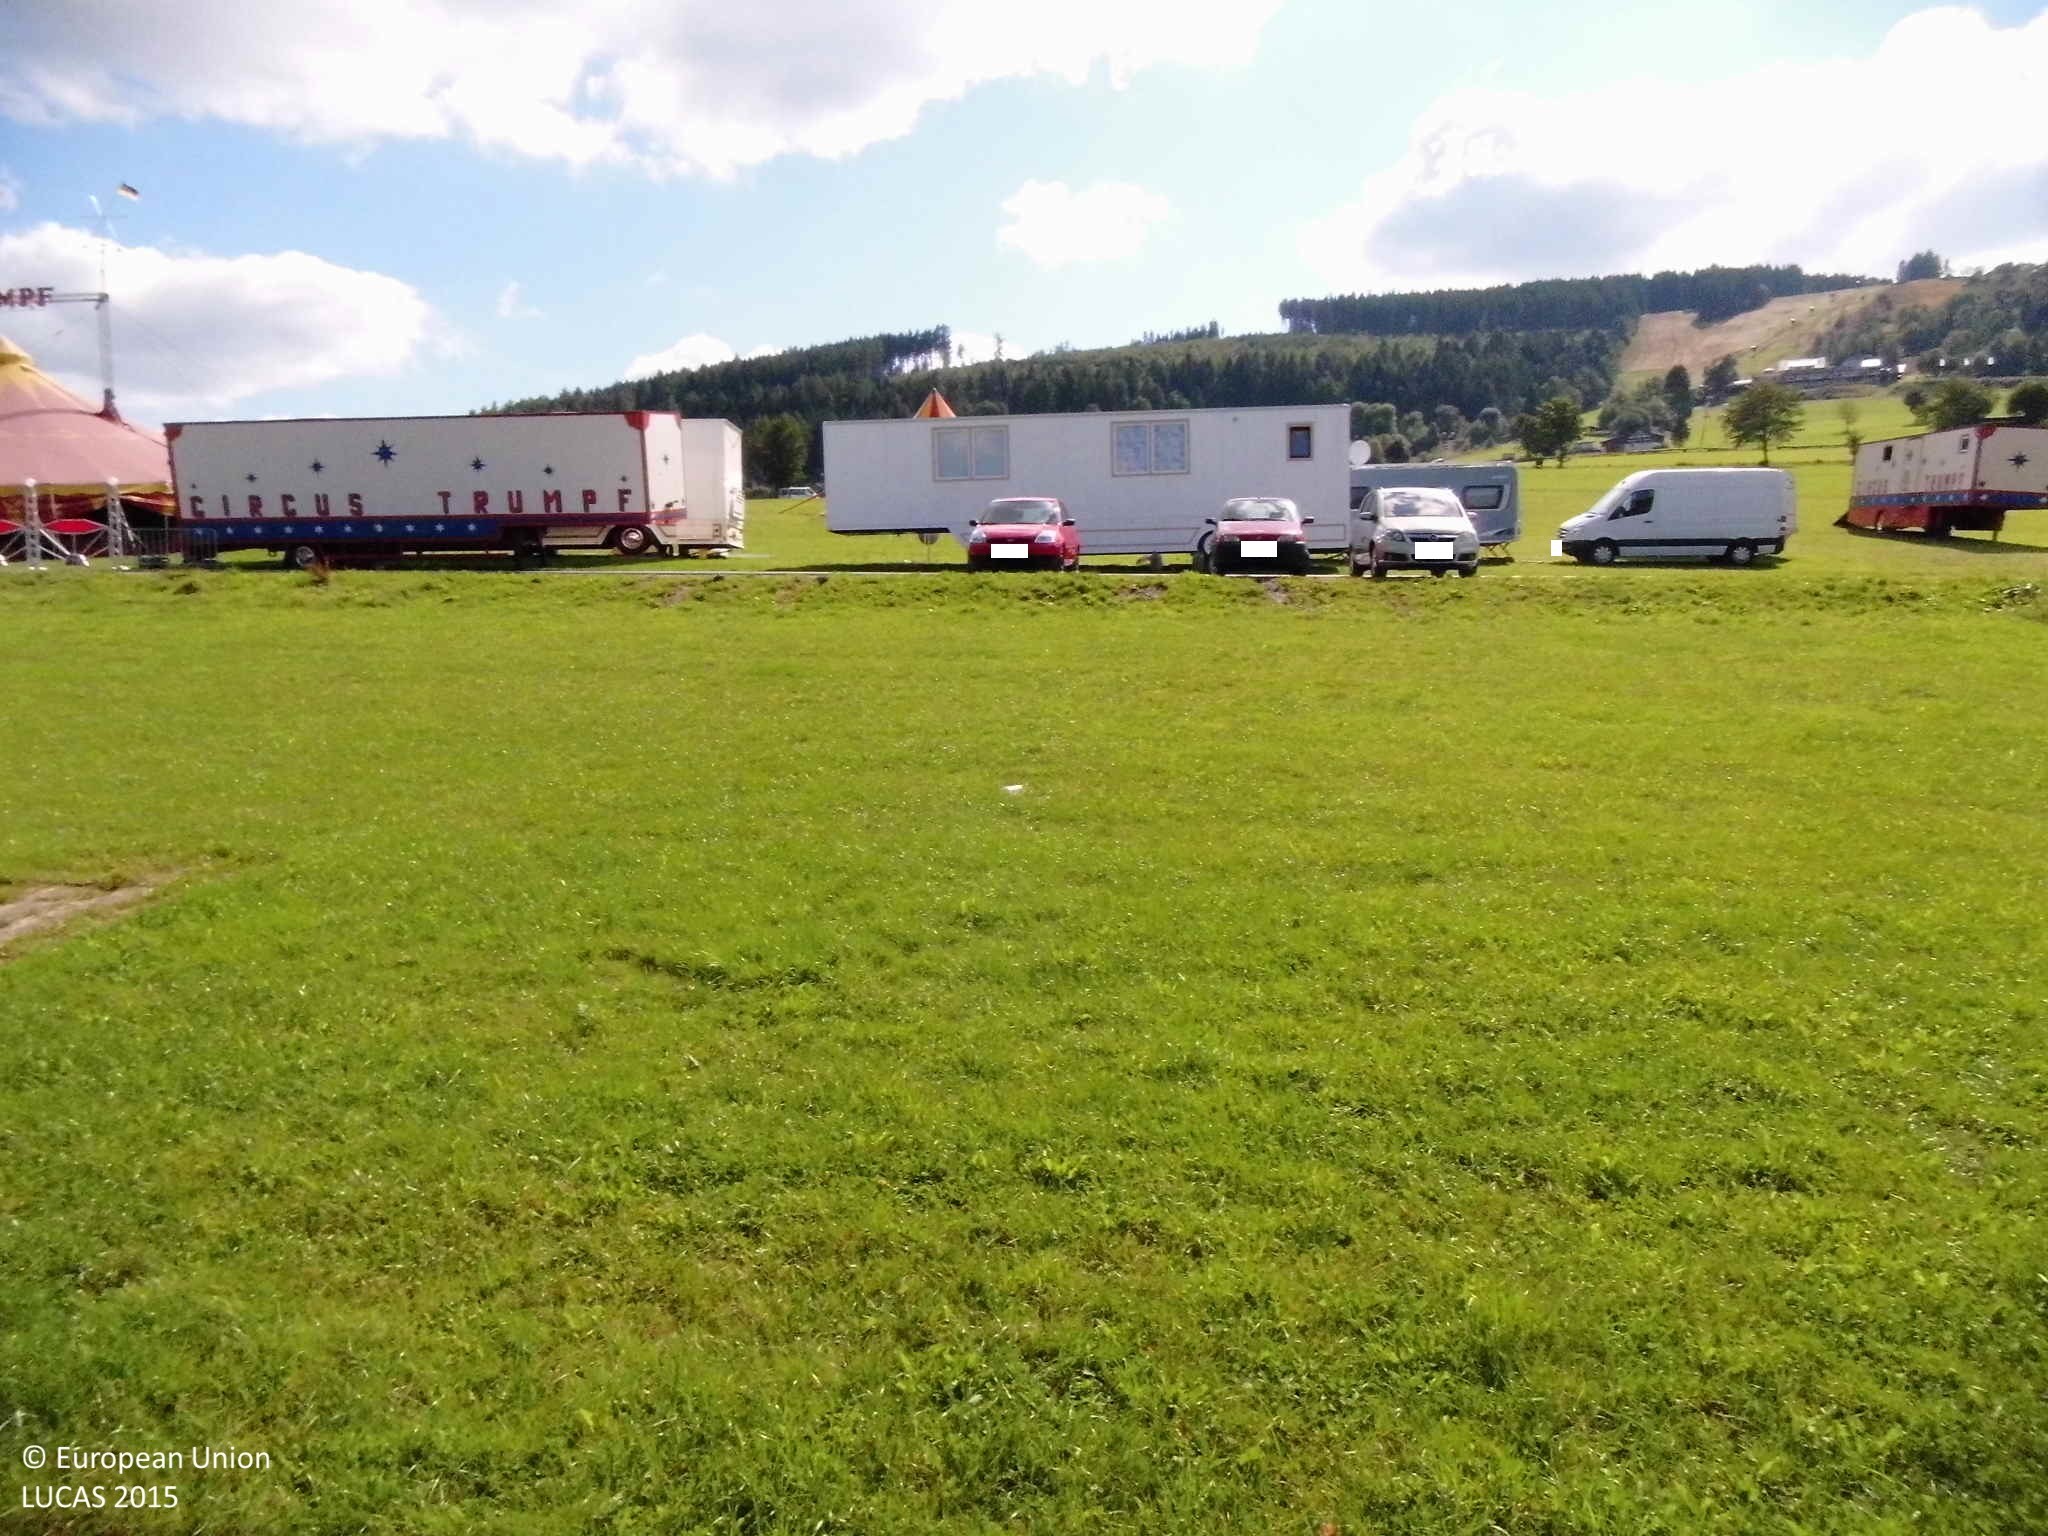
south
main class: Grassland
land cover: Grassland without tree/shrub cover
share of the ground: > 75 %
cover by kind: herbaceous plants 100 %
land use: Air transport
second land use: Agriculture (excluding fallow land and kitchen gardens)
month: September
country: DE
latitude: 51.2906
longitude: 8.6094
